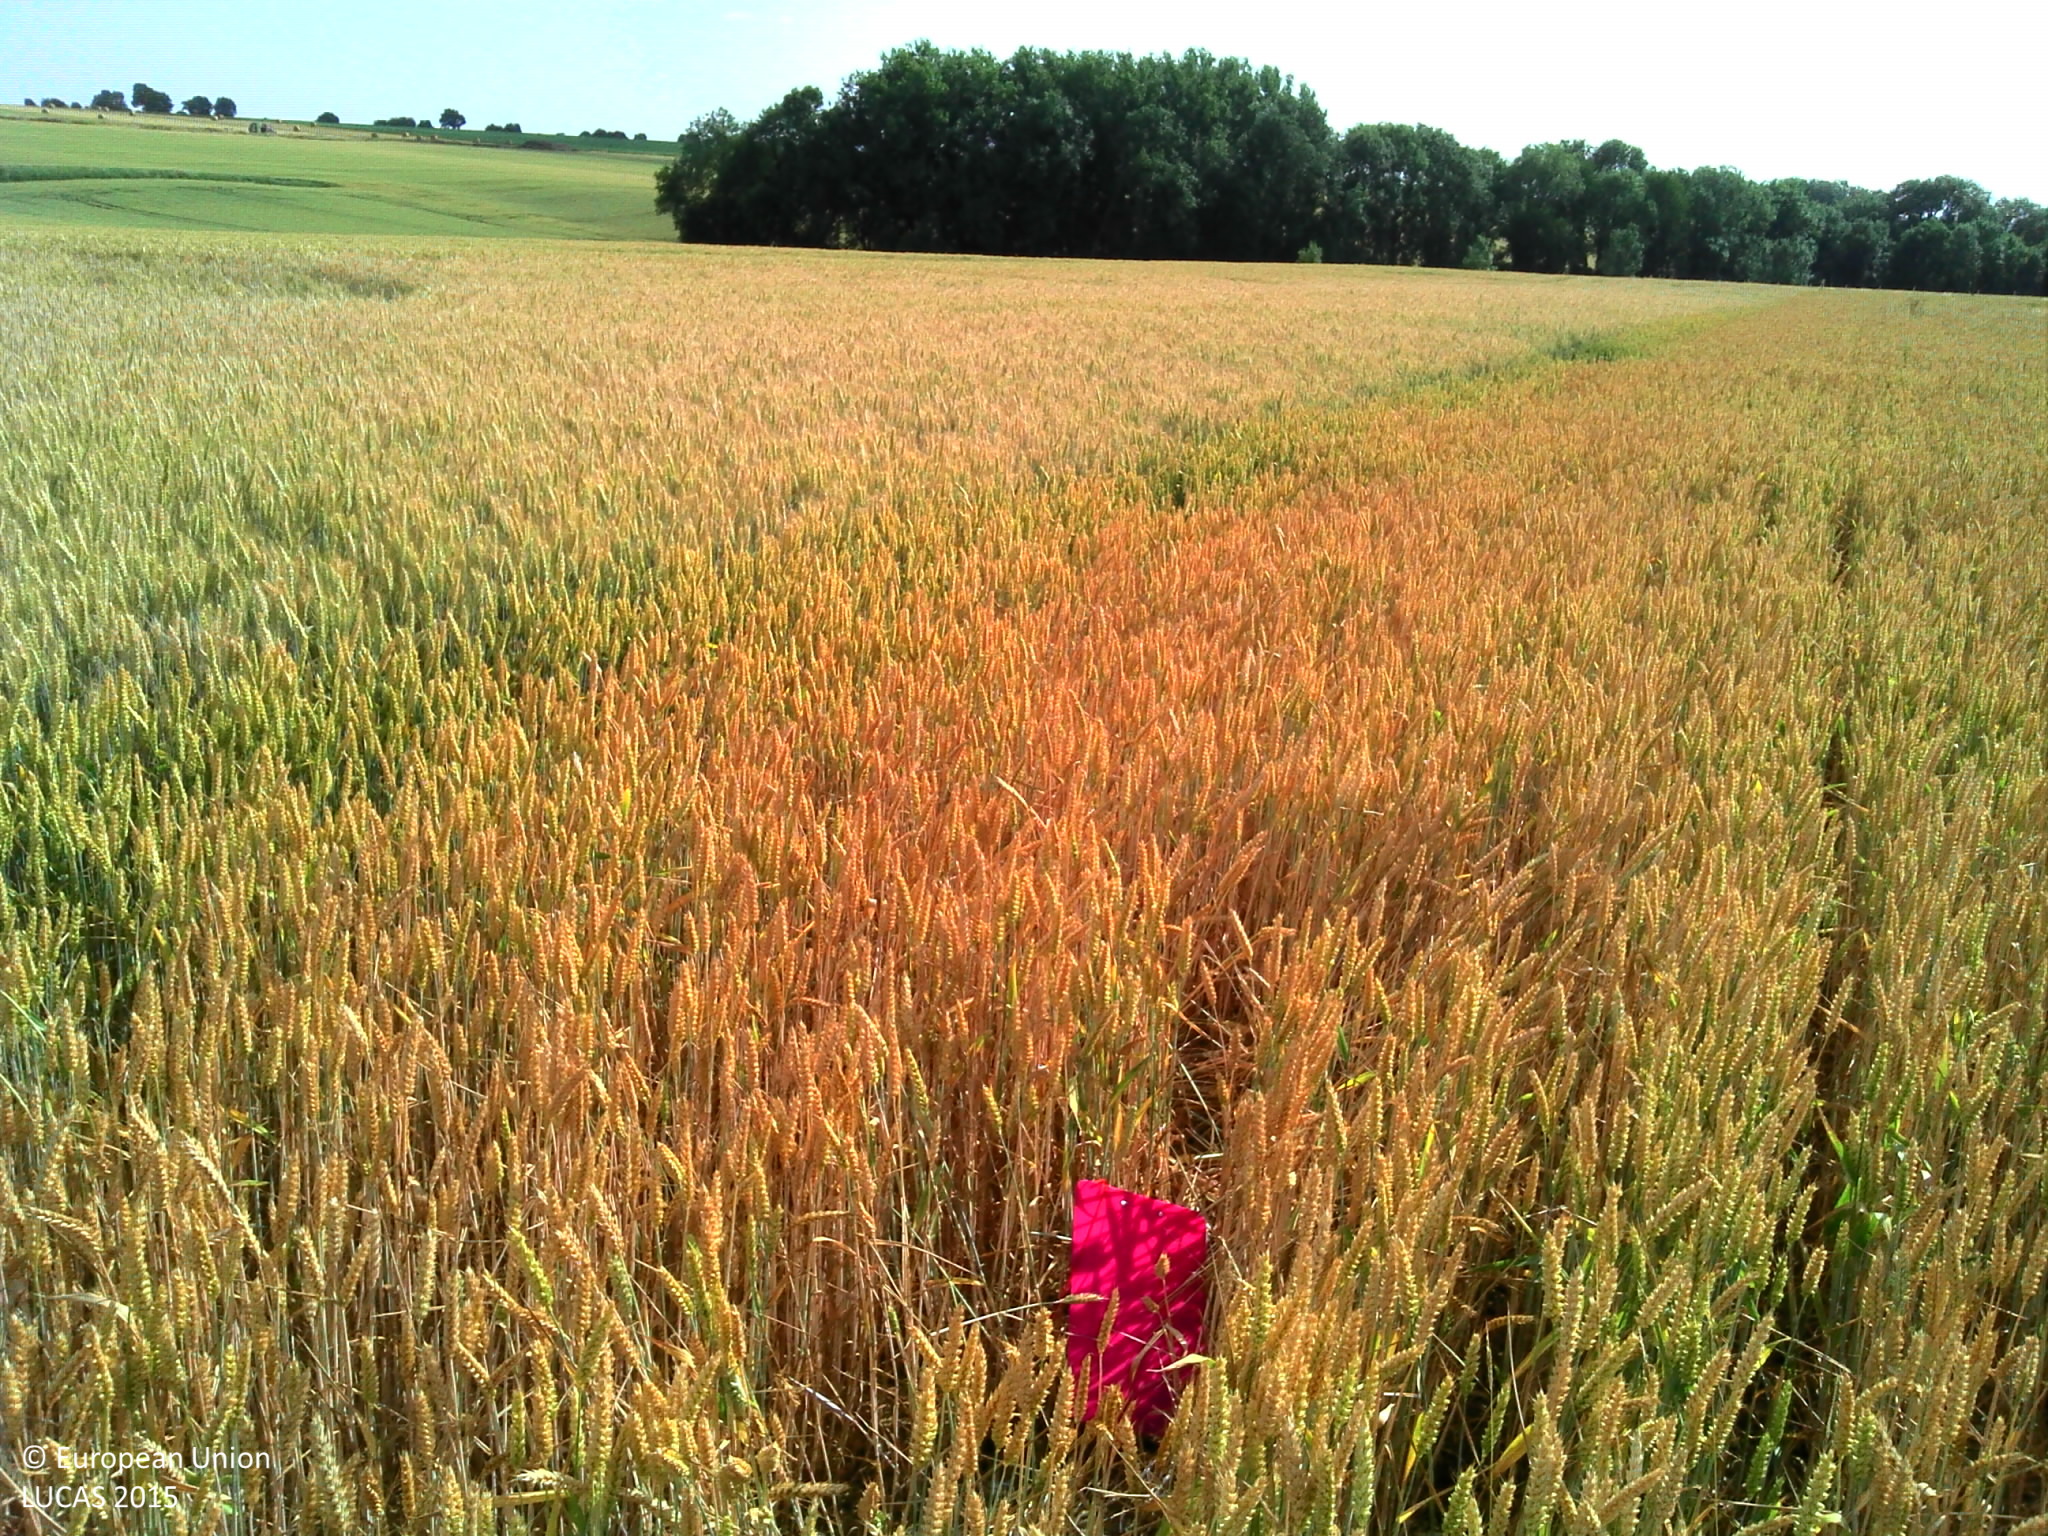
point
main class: Cropland
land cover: Common wheat
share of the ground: > 75 %
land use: Agriculture (excluding fallow land and kitchen gardens)
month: July
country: FR
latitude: 50.2901
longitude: 2.1109
